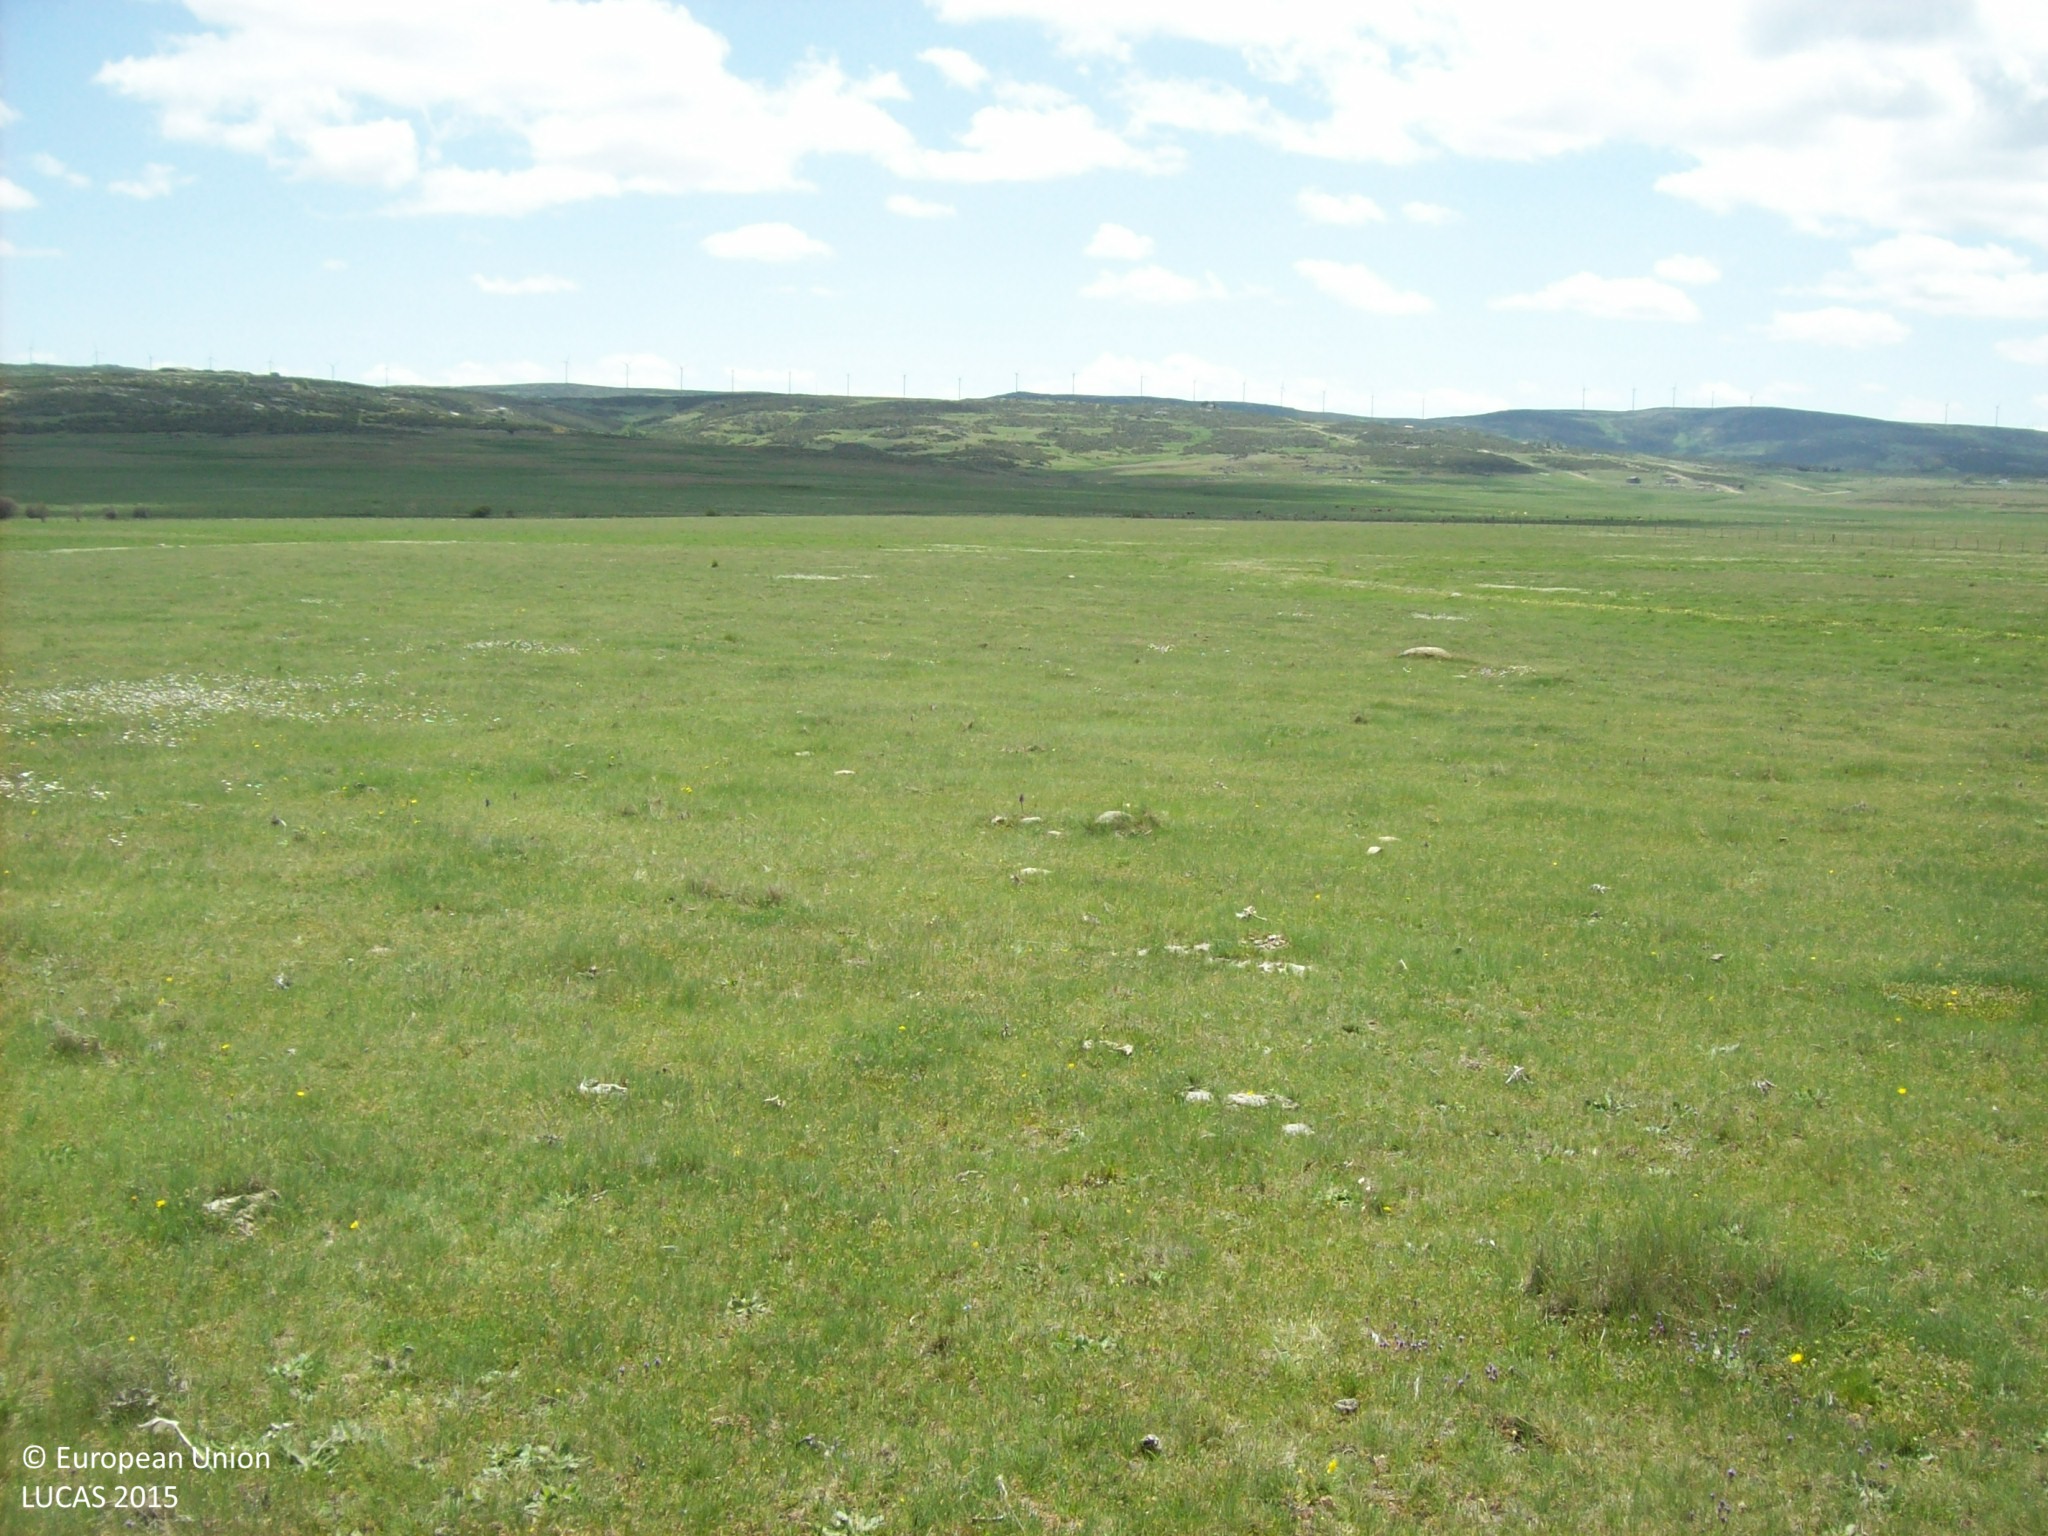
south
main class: Grassland
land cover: Grassland without tree/shrub cover
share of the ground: > 75 %
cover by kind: herbaceous plants 100 %
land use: Agriculture (excluding fallow land and kitchen gardens)
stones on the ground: < 10 %
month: May
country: ES
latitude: 40.6804
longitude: -4.4268
